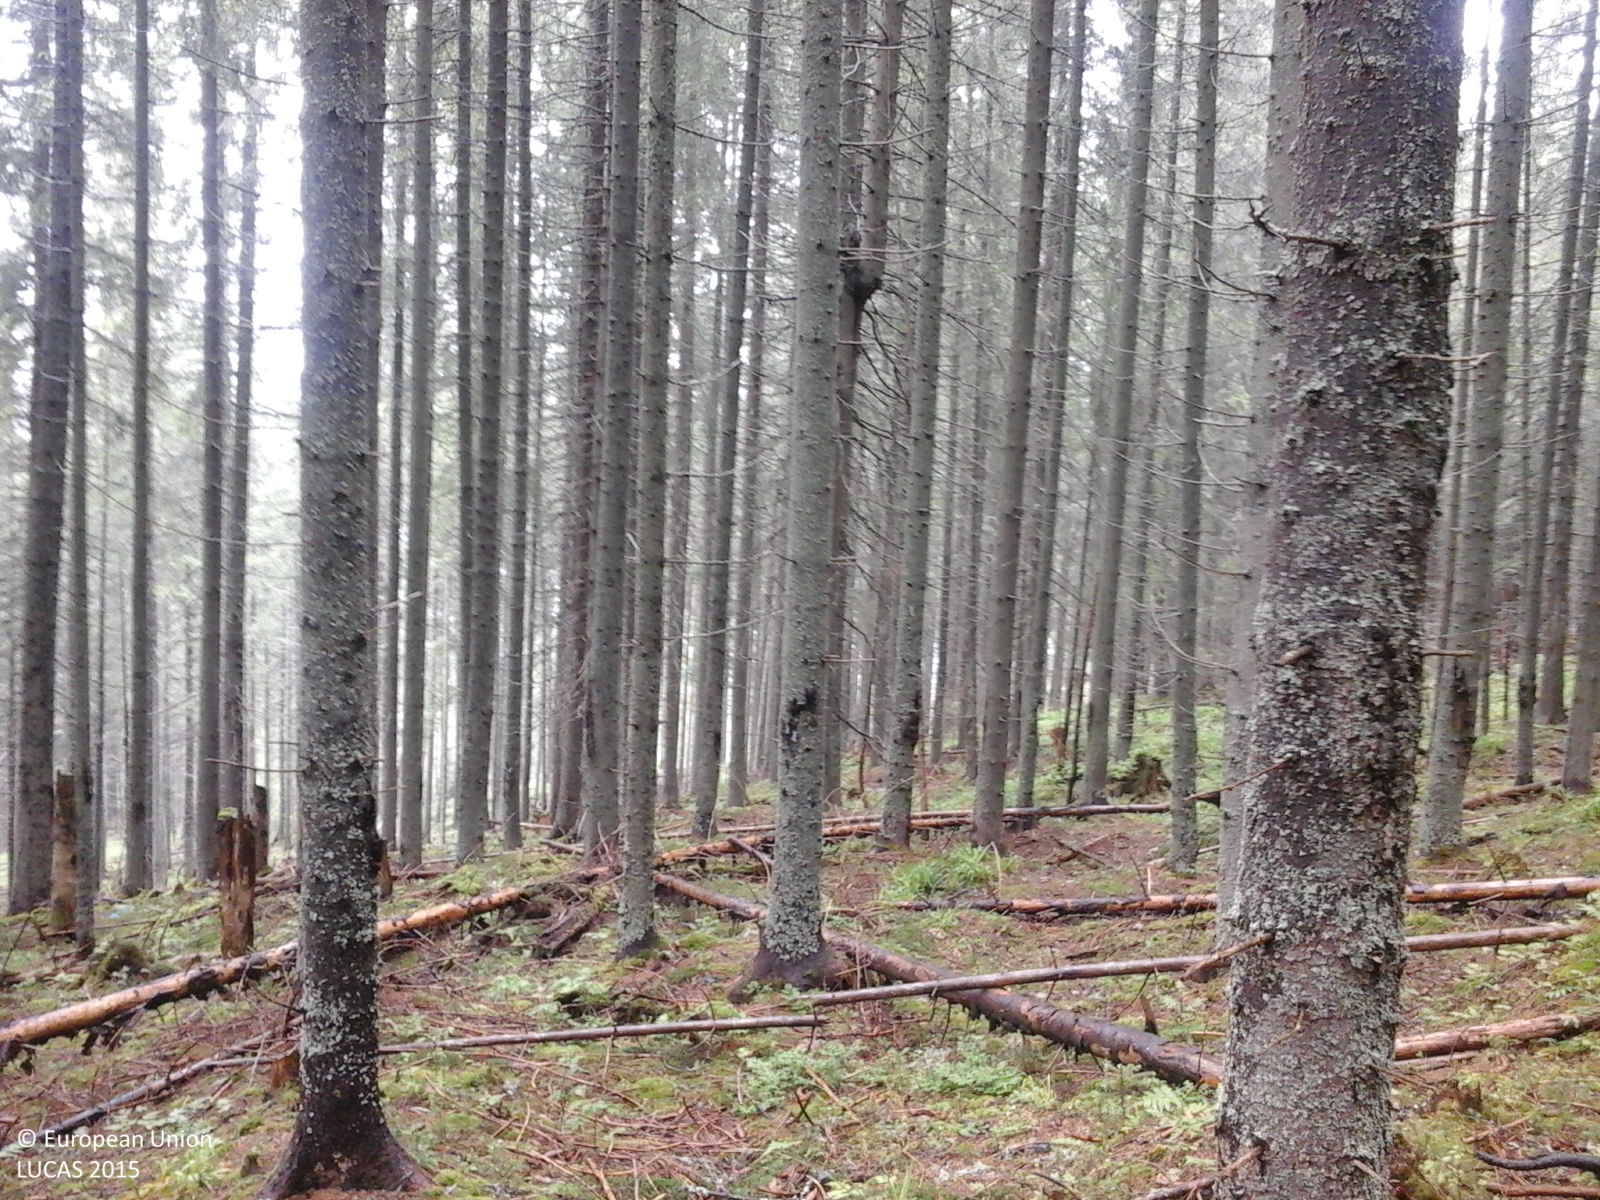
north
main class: Woodland
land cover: Spruce dominated coniferous woodland
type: alpine coniferous forest
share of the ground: > 75 %
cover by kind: coniferous forest trees 90 %, herbaceous plants 5 %, lichens and mosses 5 %
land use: Forestry
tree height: > 5 m
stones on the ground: 10 - 25 %
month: June
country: RO
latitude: 47.4162
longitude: 25.3407
